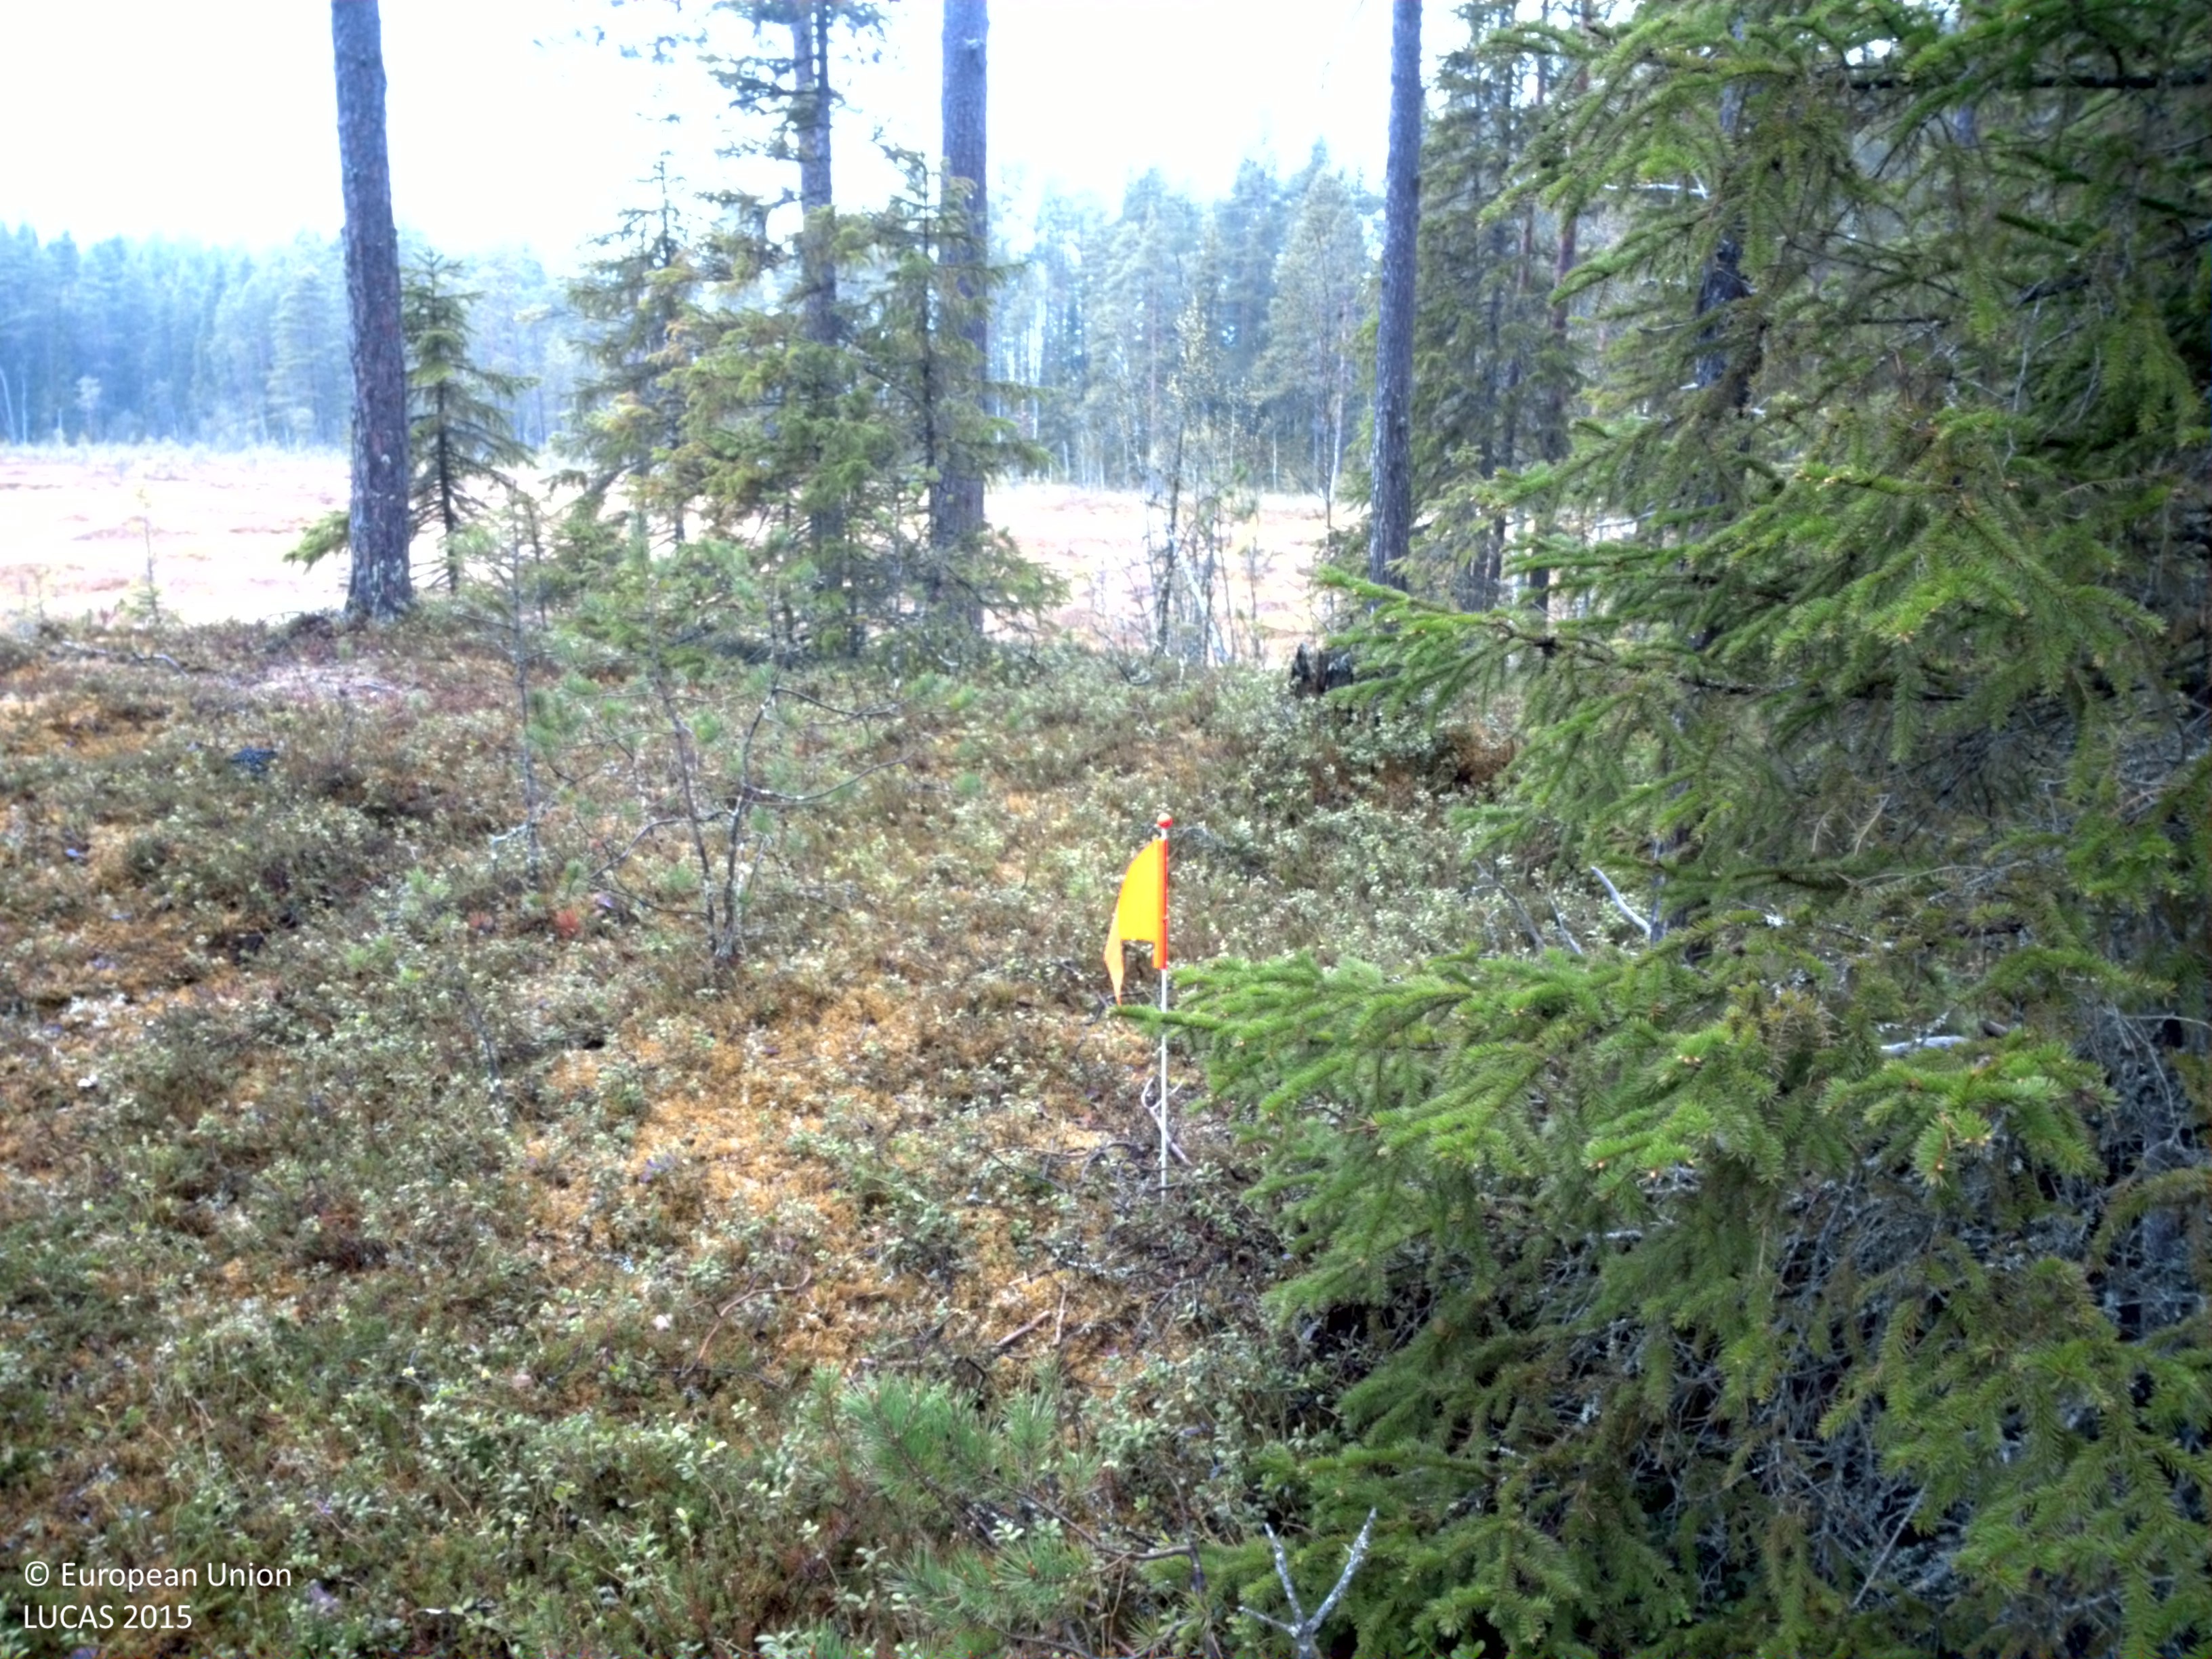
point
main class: Woodland
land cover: Pine dominated coniferous woodland
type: boreal forest
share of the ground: > 75 %
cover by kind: coniferous forest trees 80 %, broadleaved forest trees 10 %, shrubs 10 %
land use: Forestry
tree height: > 5 m
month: June
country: SE
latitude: 63.3924
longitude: 14.5610
